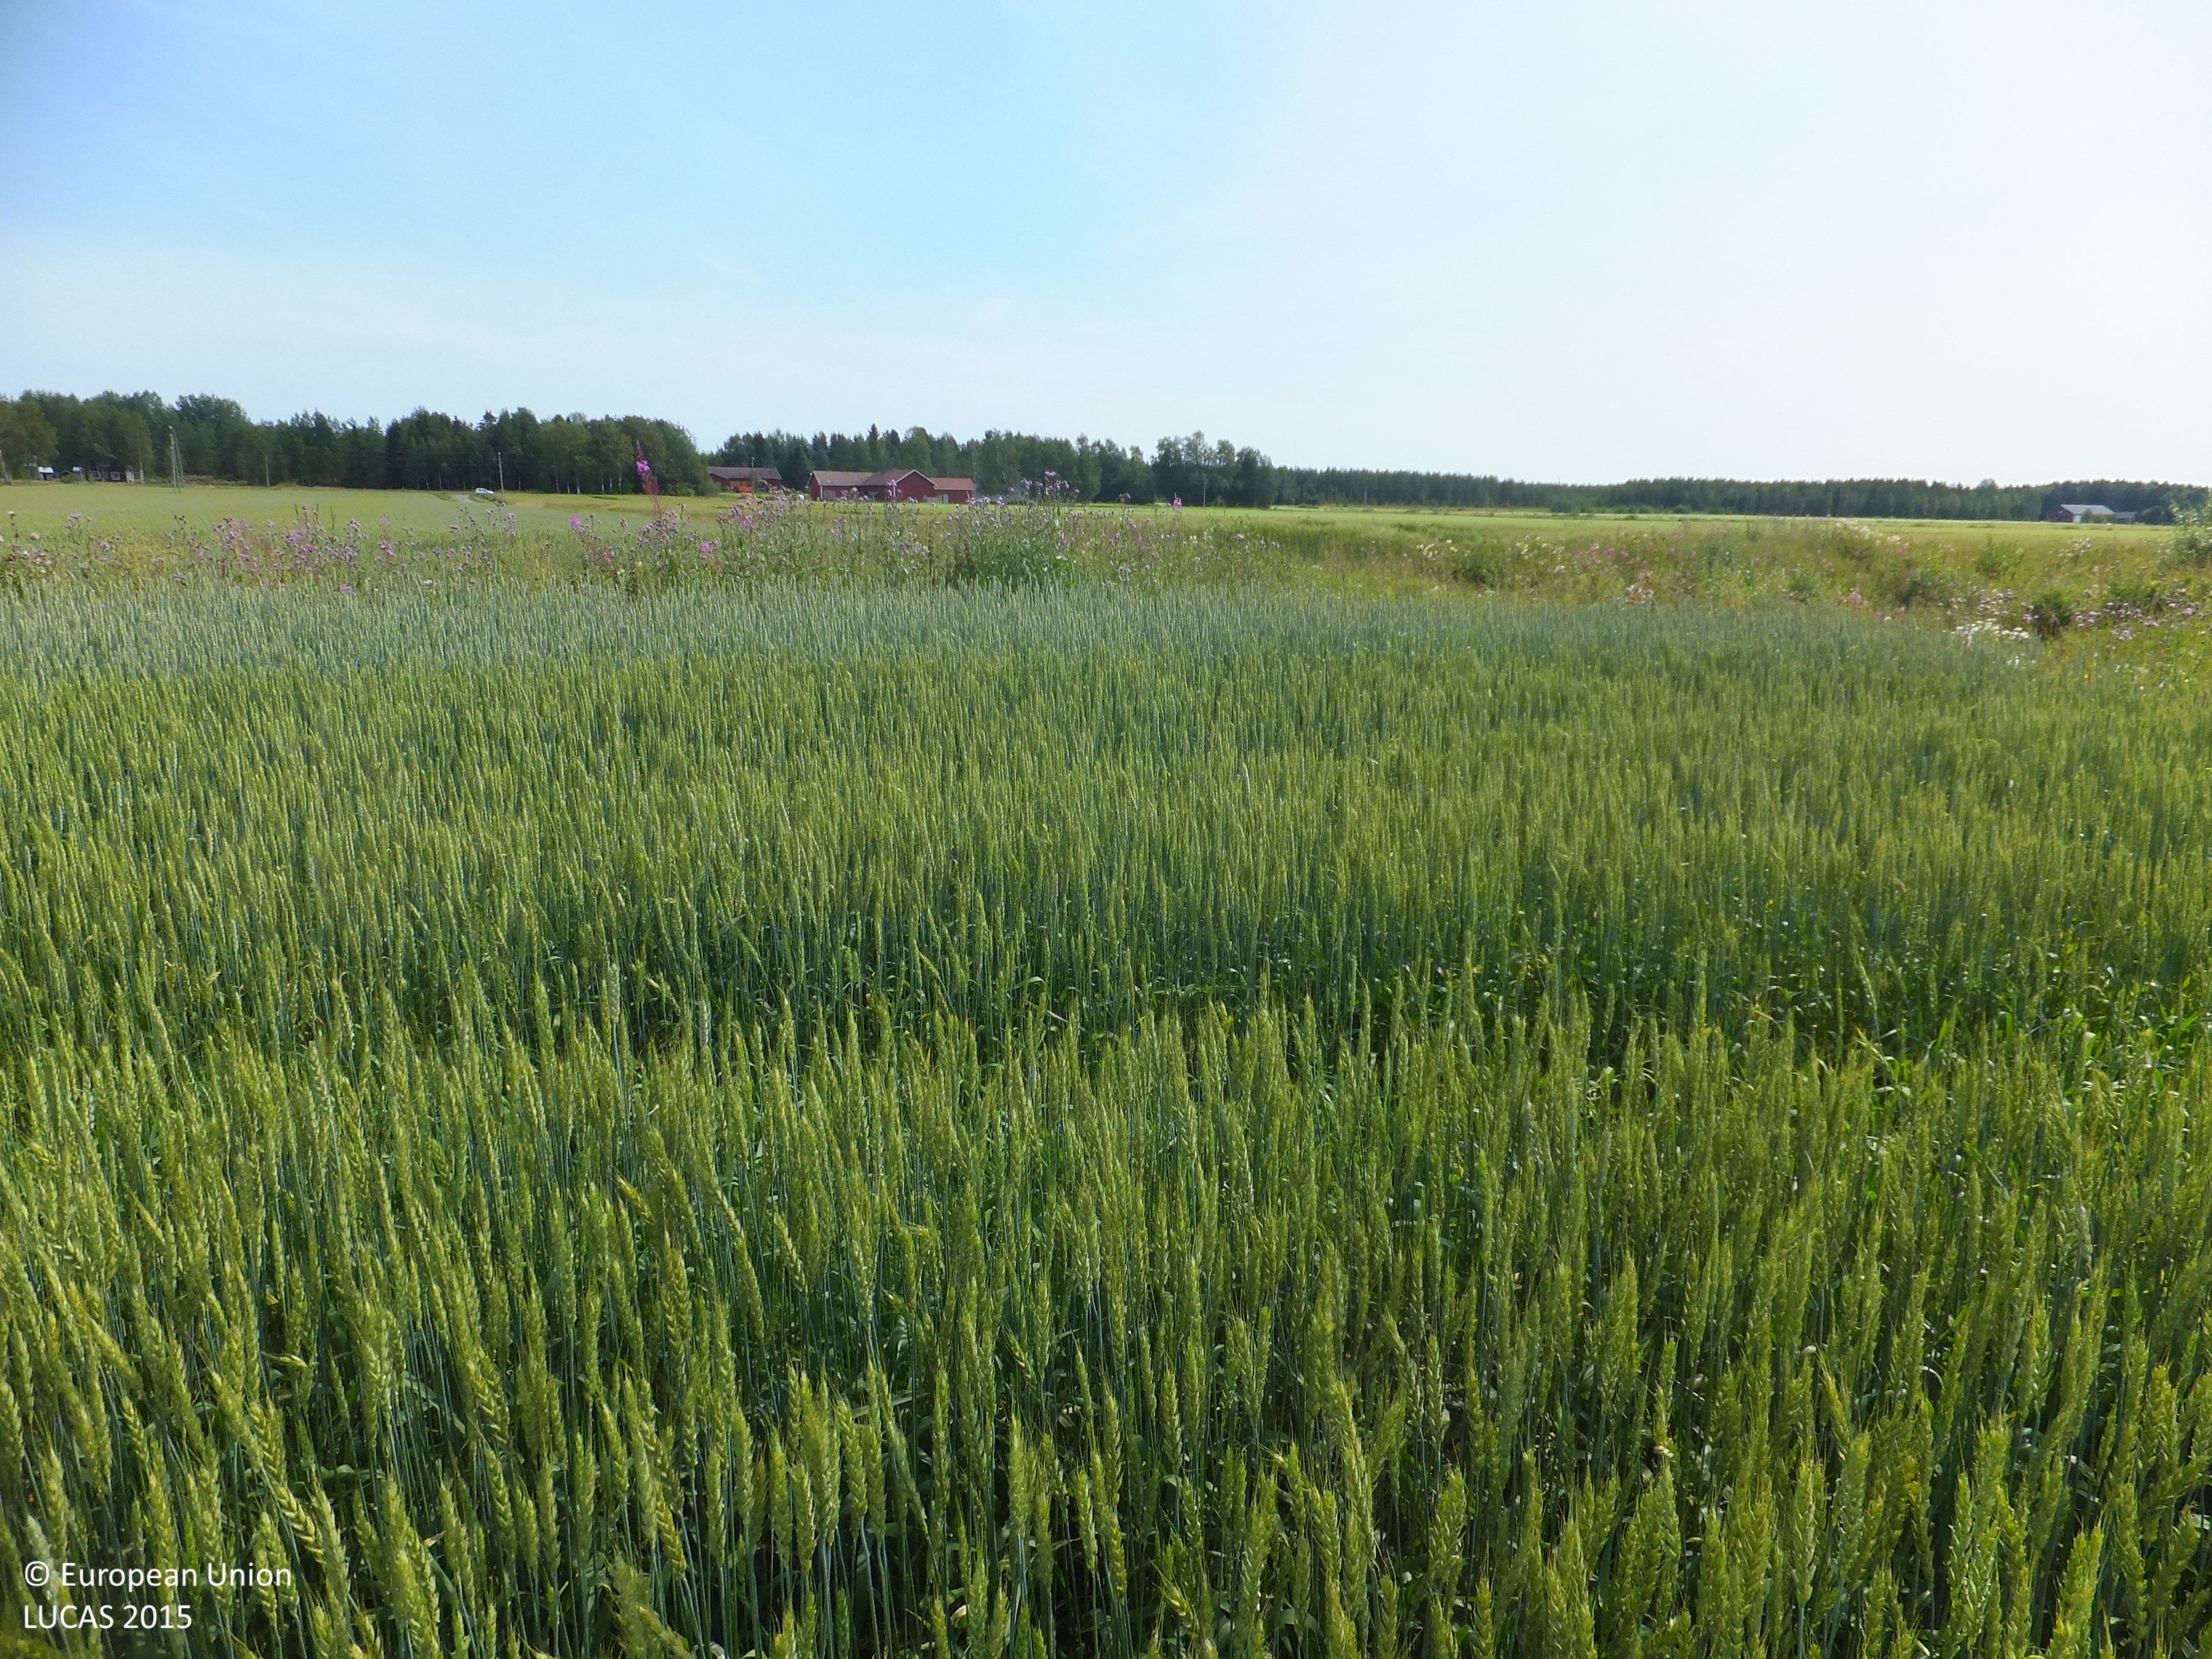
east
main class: Cropland
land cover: Common wheat
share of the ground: > 75 %
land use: Agriculture (excluding fallow land and kitchen gardens)
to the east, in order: Common wheat; Grass margins; Ditches and canals; Grass margins; Common wheat
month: August
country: FI
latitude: 63.2170
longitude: 22.8043
